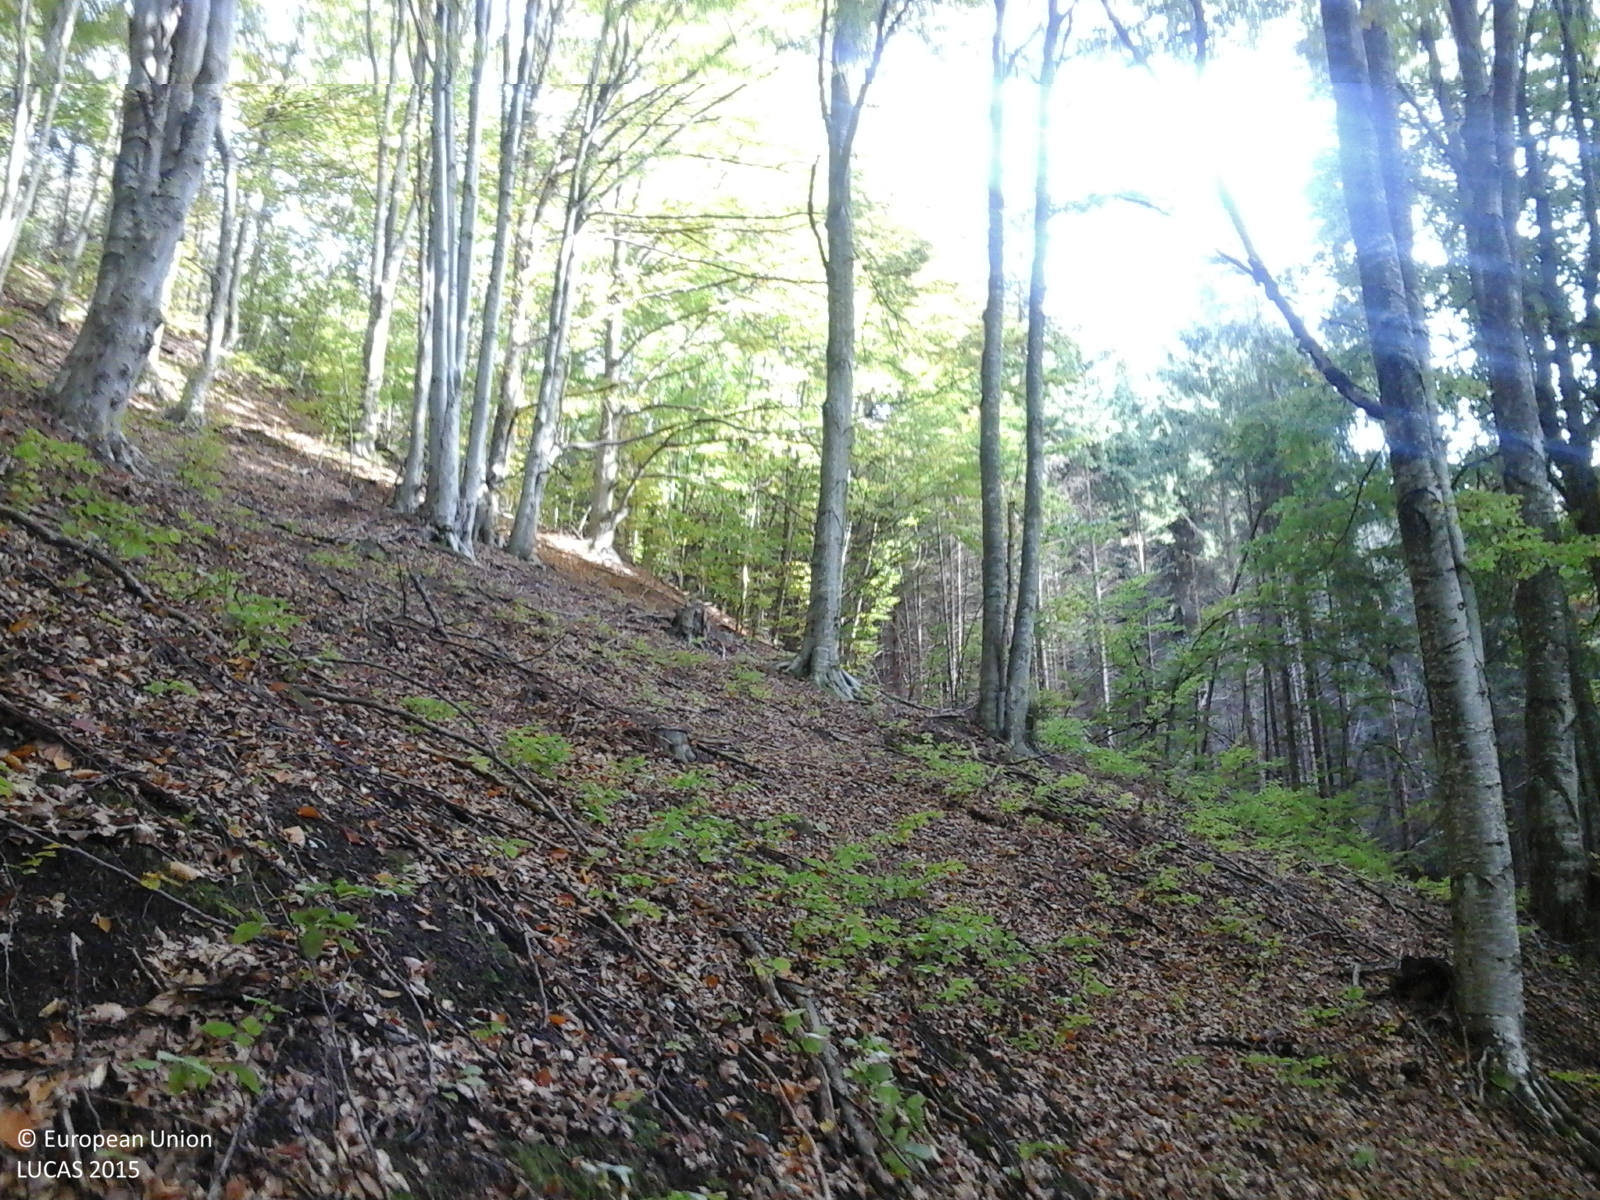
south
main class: Woodland
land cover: Broadleaved woodland
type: beech forest
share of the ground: > 75 %
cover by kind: broadleaved forest trees 100 %
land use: Forestry
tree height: > 5 m
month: October
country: RO
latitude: 46.5442
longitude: 25.1635
